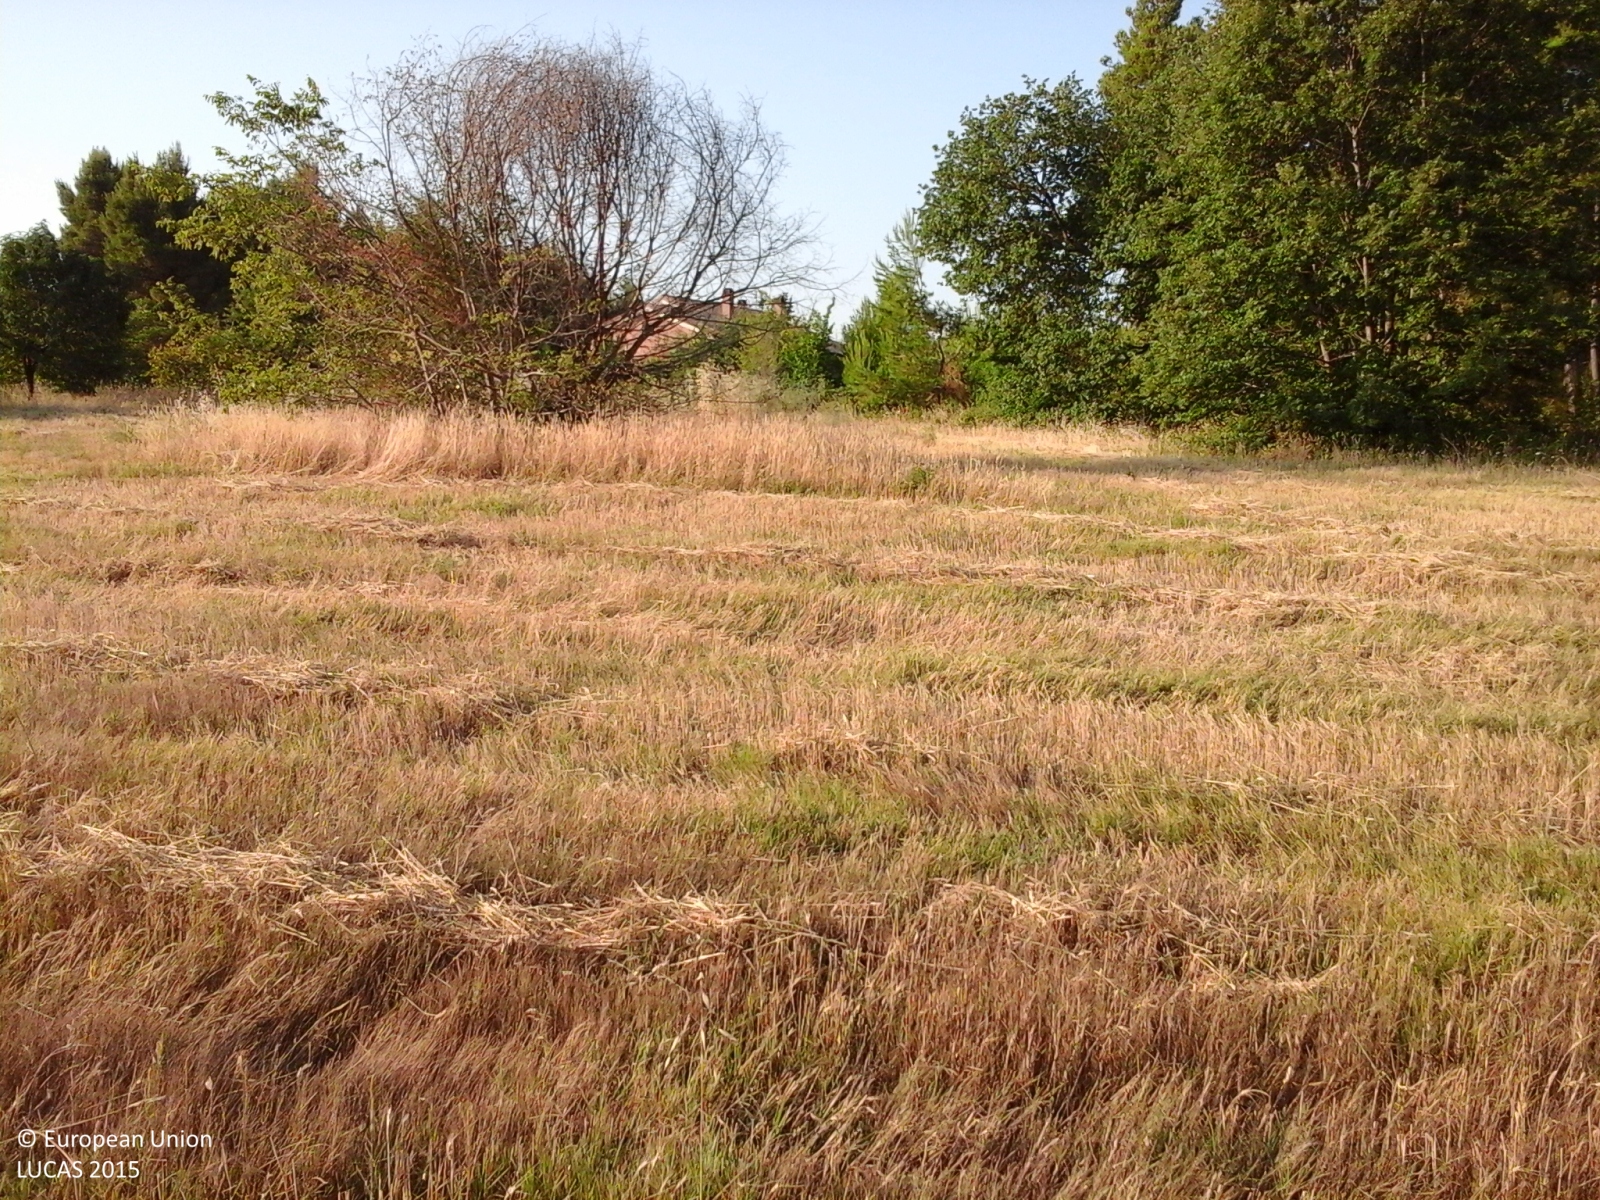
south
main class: Cropland
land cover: Durum wheat
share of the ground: > 75 %
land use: Agriculture (excluding fallow land and kitchen gardens)
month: July
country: IT
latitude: 41.5487
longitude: 14.7190
